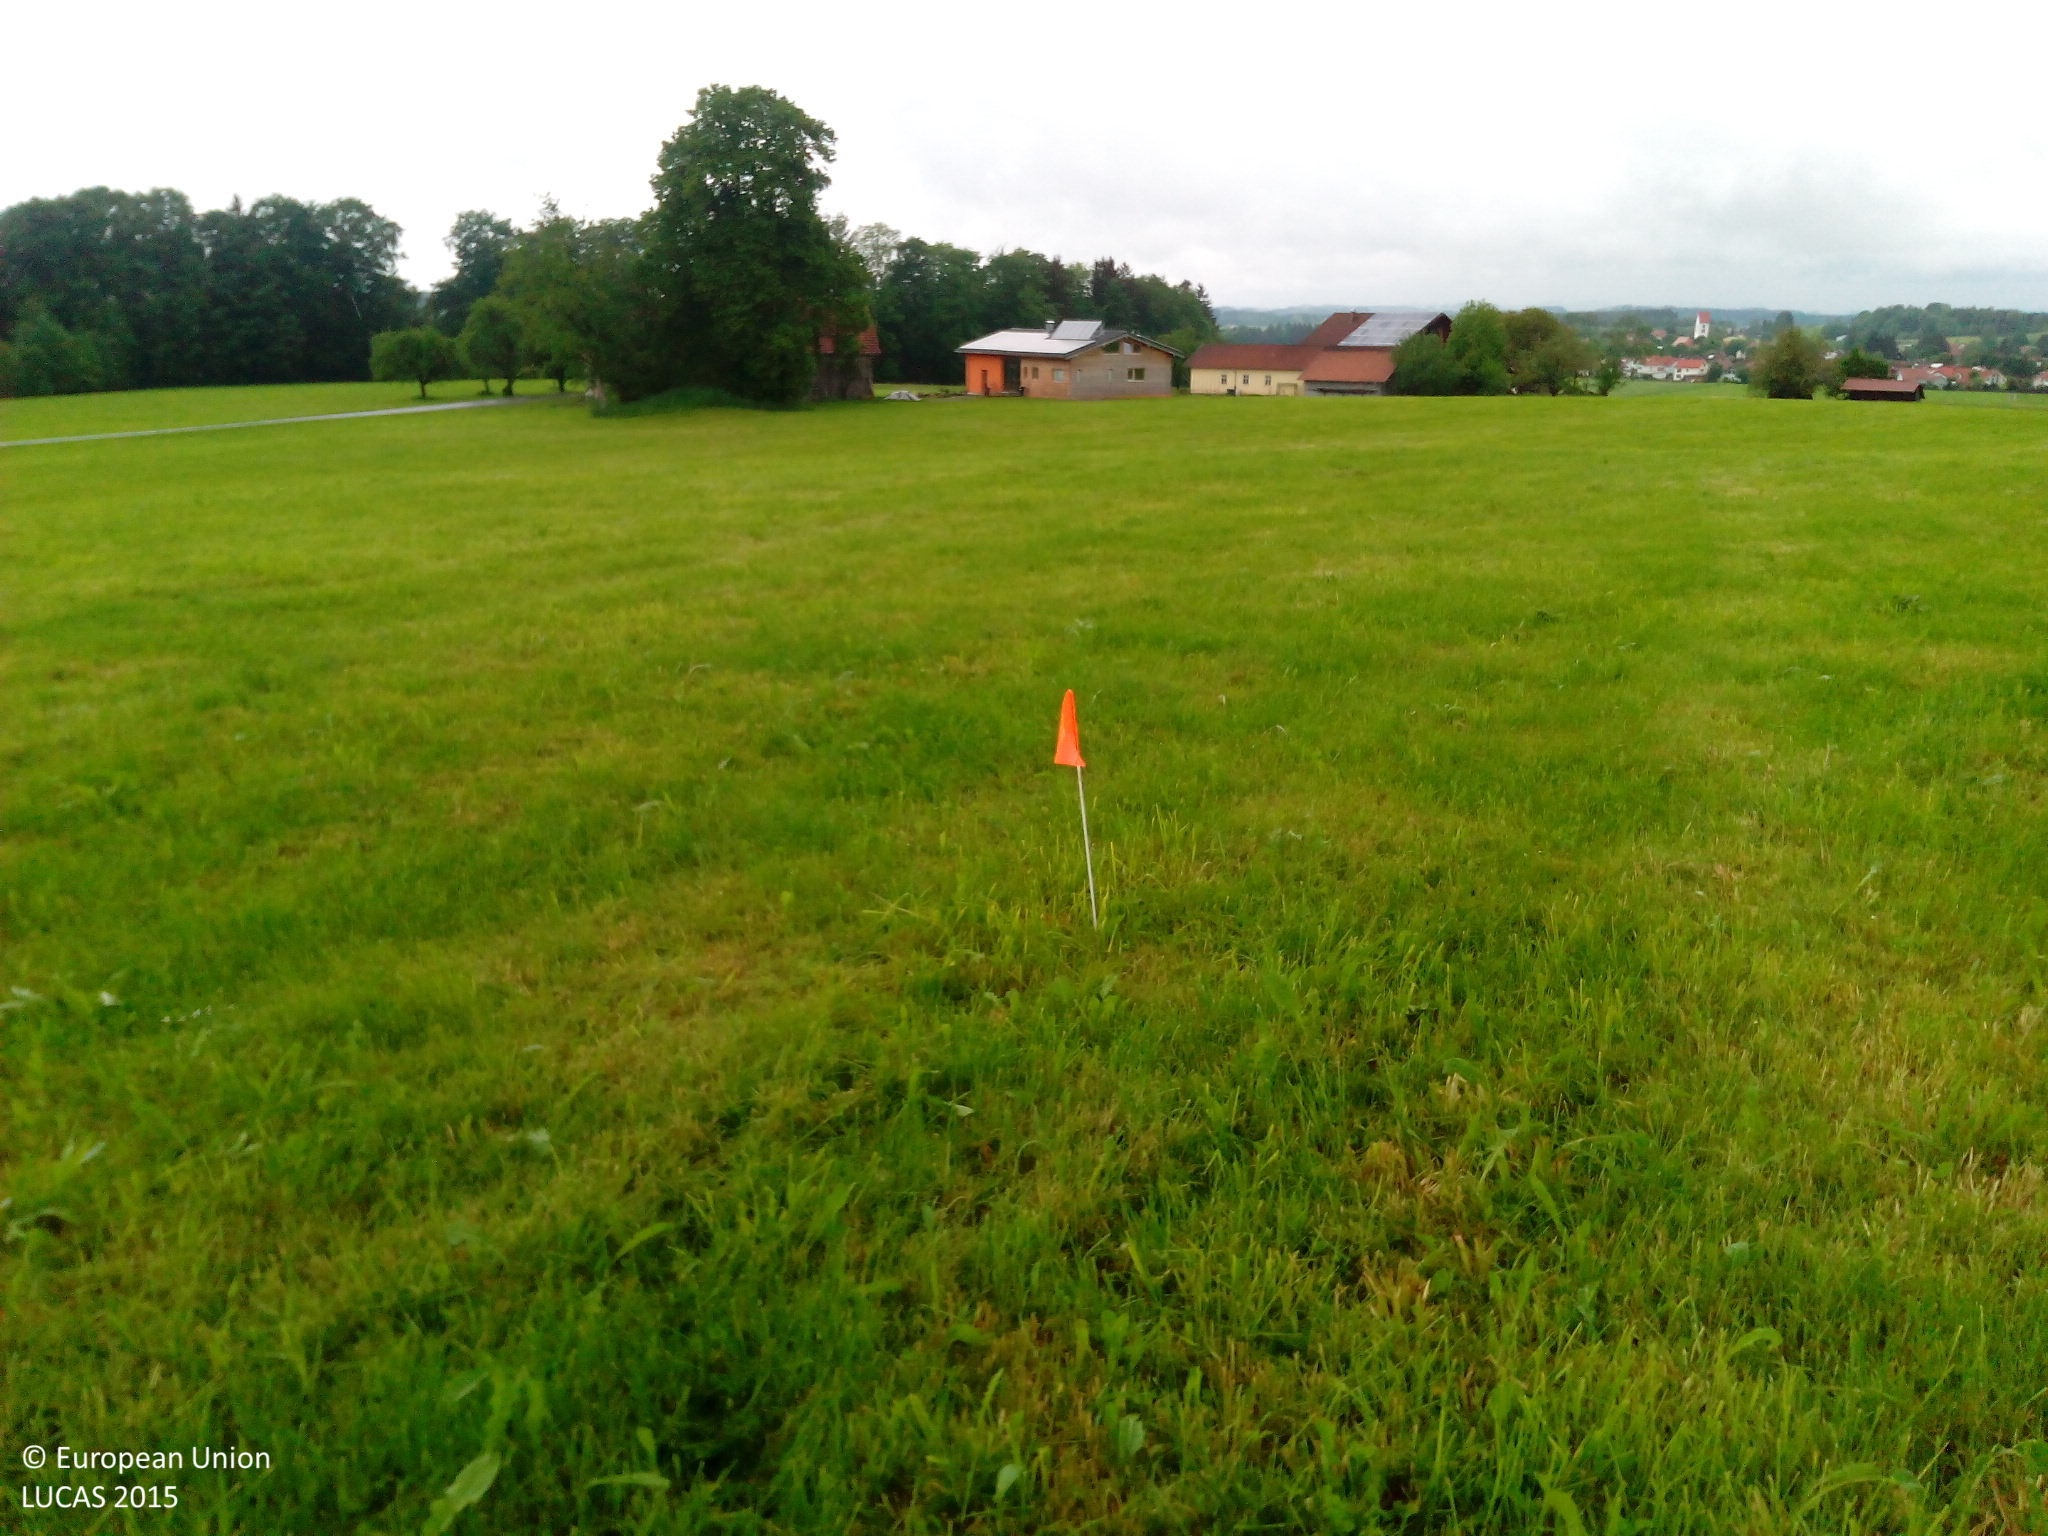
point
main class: Grassland
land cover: Grassland without tree/shrub cover
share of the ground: > 75 %
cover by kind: herbaceous plants 100 %
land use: Agriculture (excluding fallow land and kitchen gardens)
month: May
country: DE
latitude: 47.7556
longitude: 9.9334
